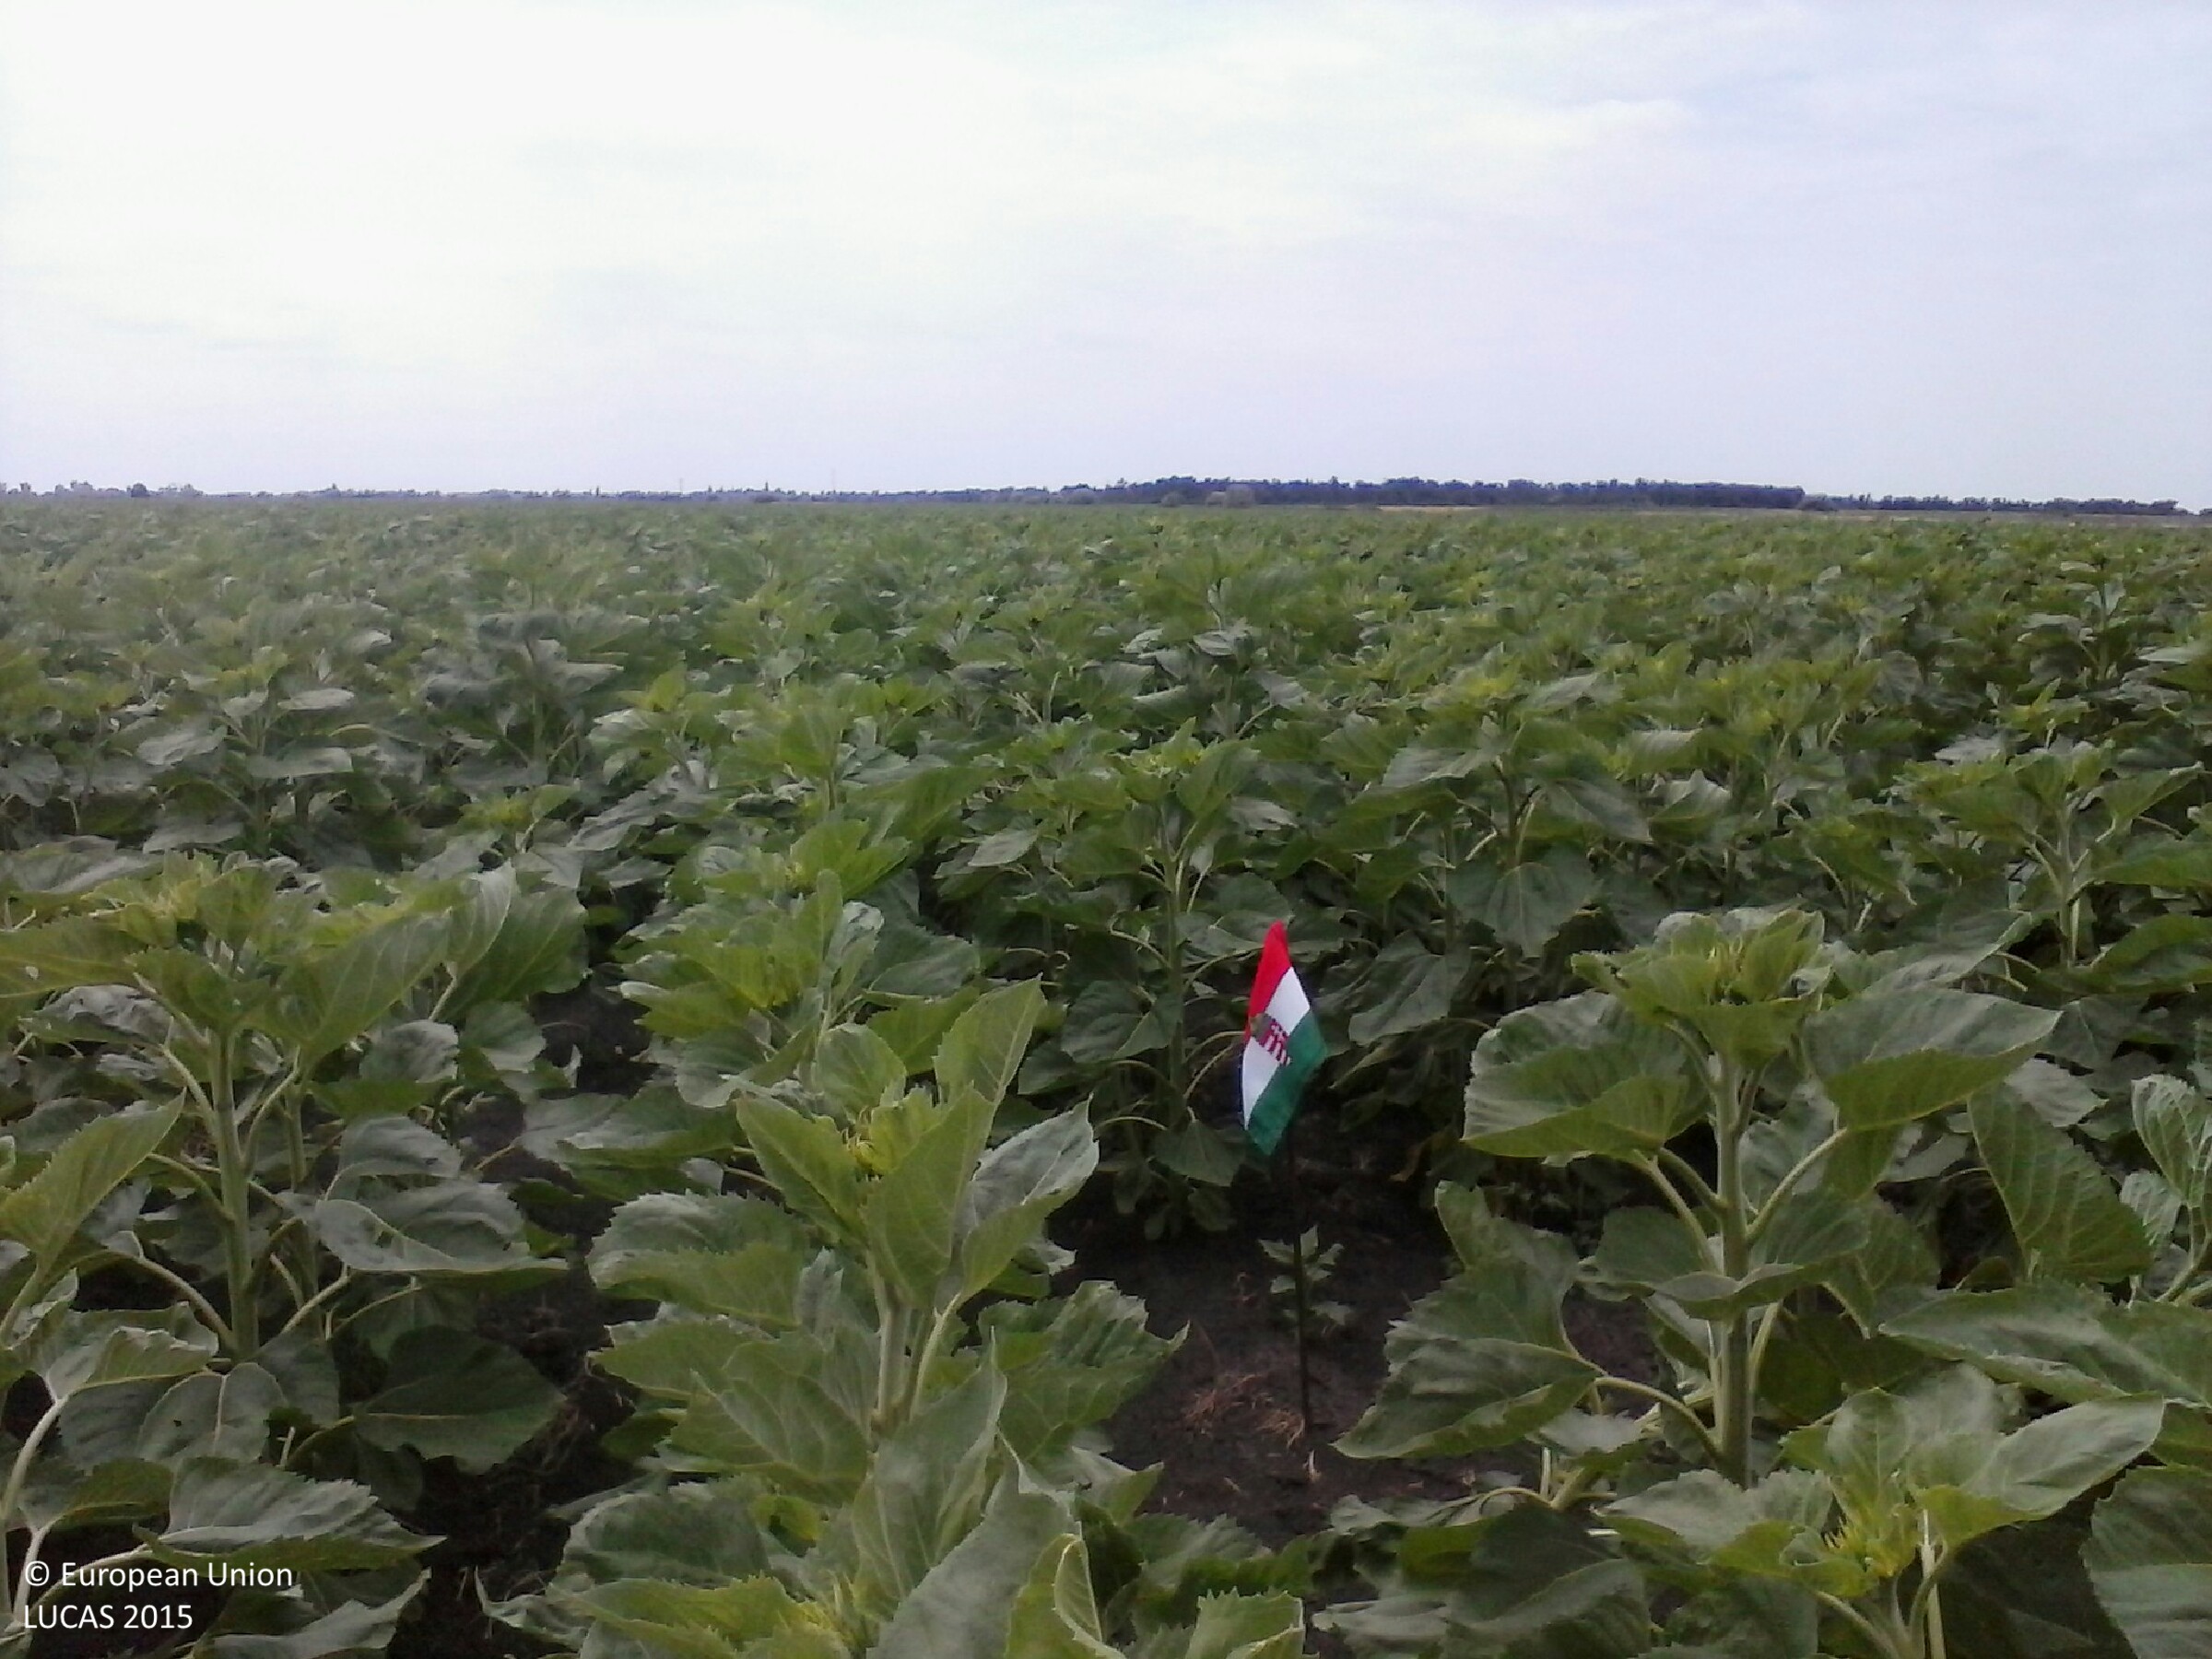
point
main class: Cropland
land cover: Sunflower
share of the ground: > 75 %
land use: Agriculture (excluding fallow land and kitchen gardens)
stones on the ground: < 10 %
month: June
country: HU
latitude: 46.1798
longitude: 20.2959
